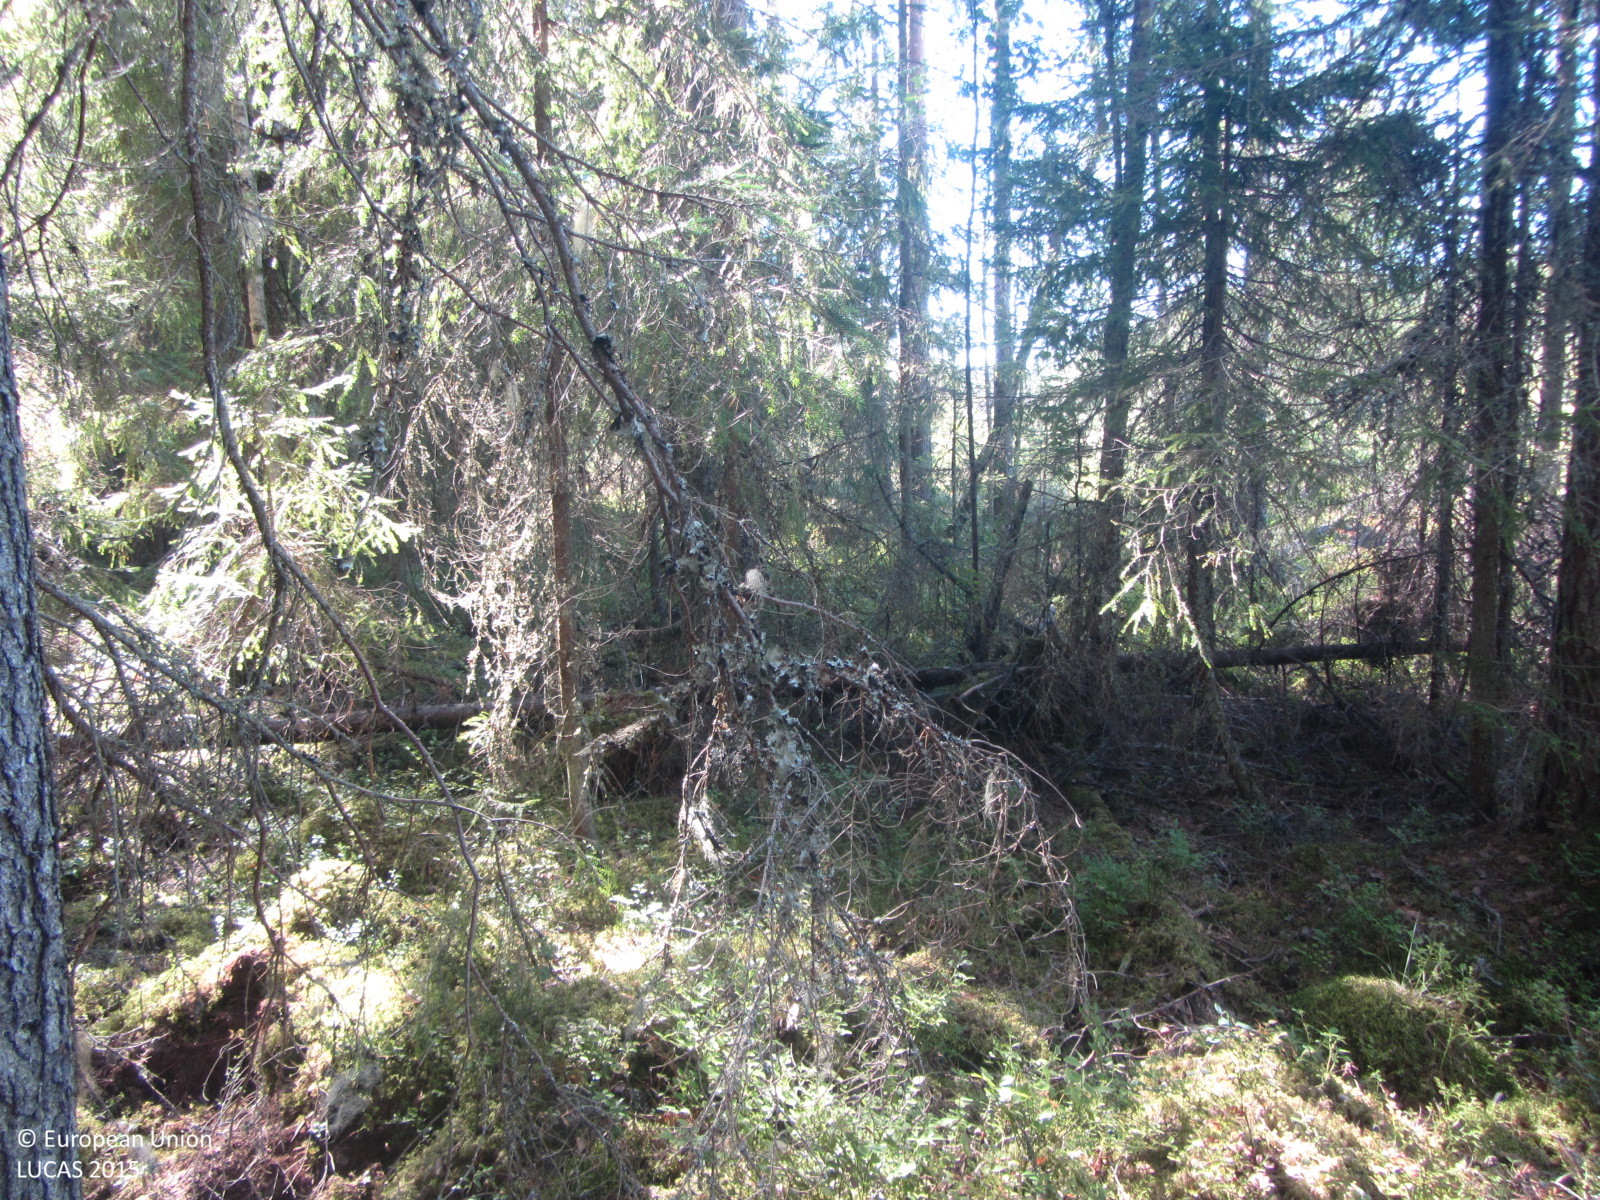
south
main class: Woodland
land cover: Other coniferous woodland
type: boreal forest
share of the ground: > 75 %
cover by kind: coniferous forest trees 80 %, shrubs 10 %, broadleaved forest trees 5 %, lichens and mosses 5 %
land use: Forestry
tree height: > 5 m
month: August
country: FI
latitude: 61.3445
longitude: 25.1245
